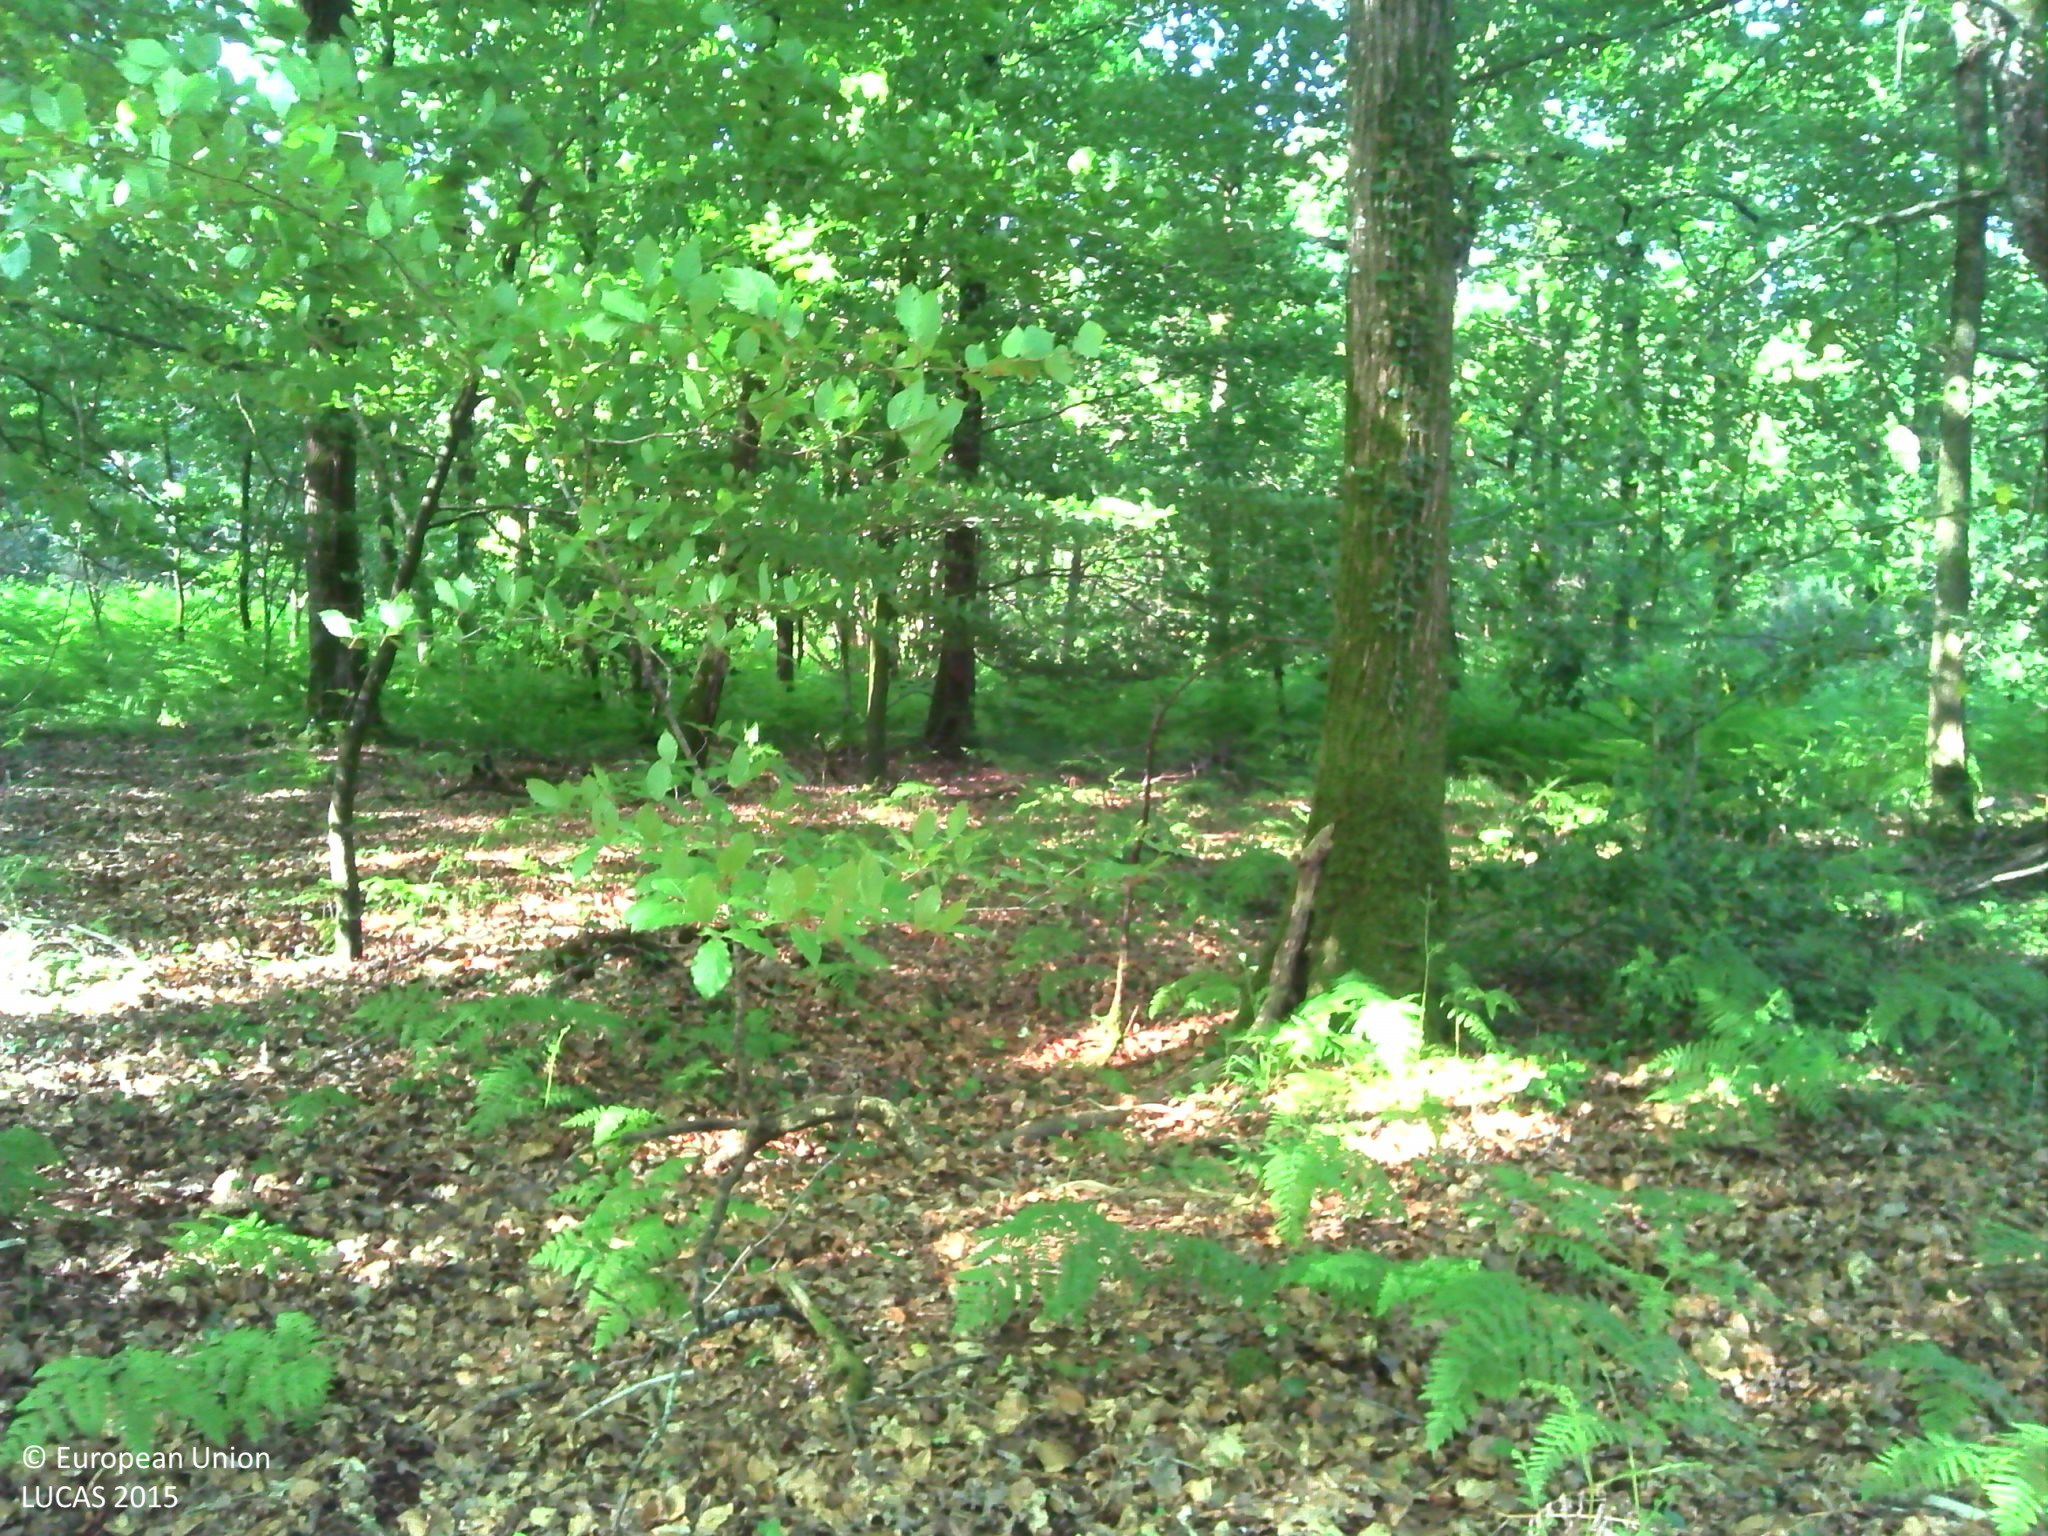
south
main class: Woodland
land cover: Broadleaved woodland
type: acidophilous oak and oak-birch forest
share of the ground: > 75 %
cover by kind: broadleaved forest trees 90 %, herbaceous plants 10 %
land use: Forestry
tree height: > 5 m
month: June
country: FR
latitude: 48.2113
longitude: -1.2256
